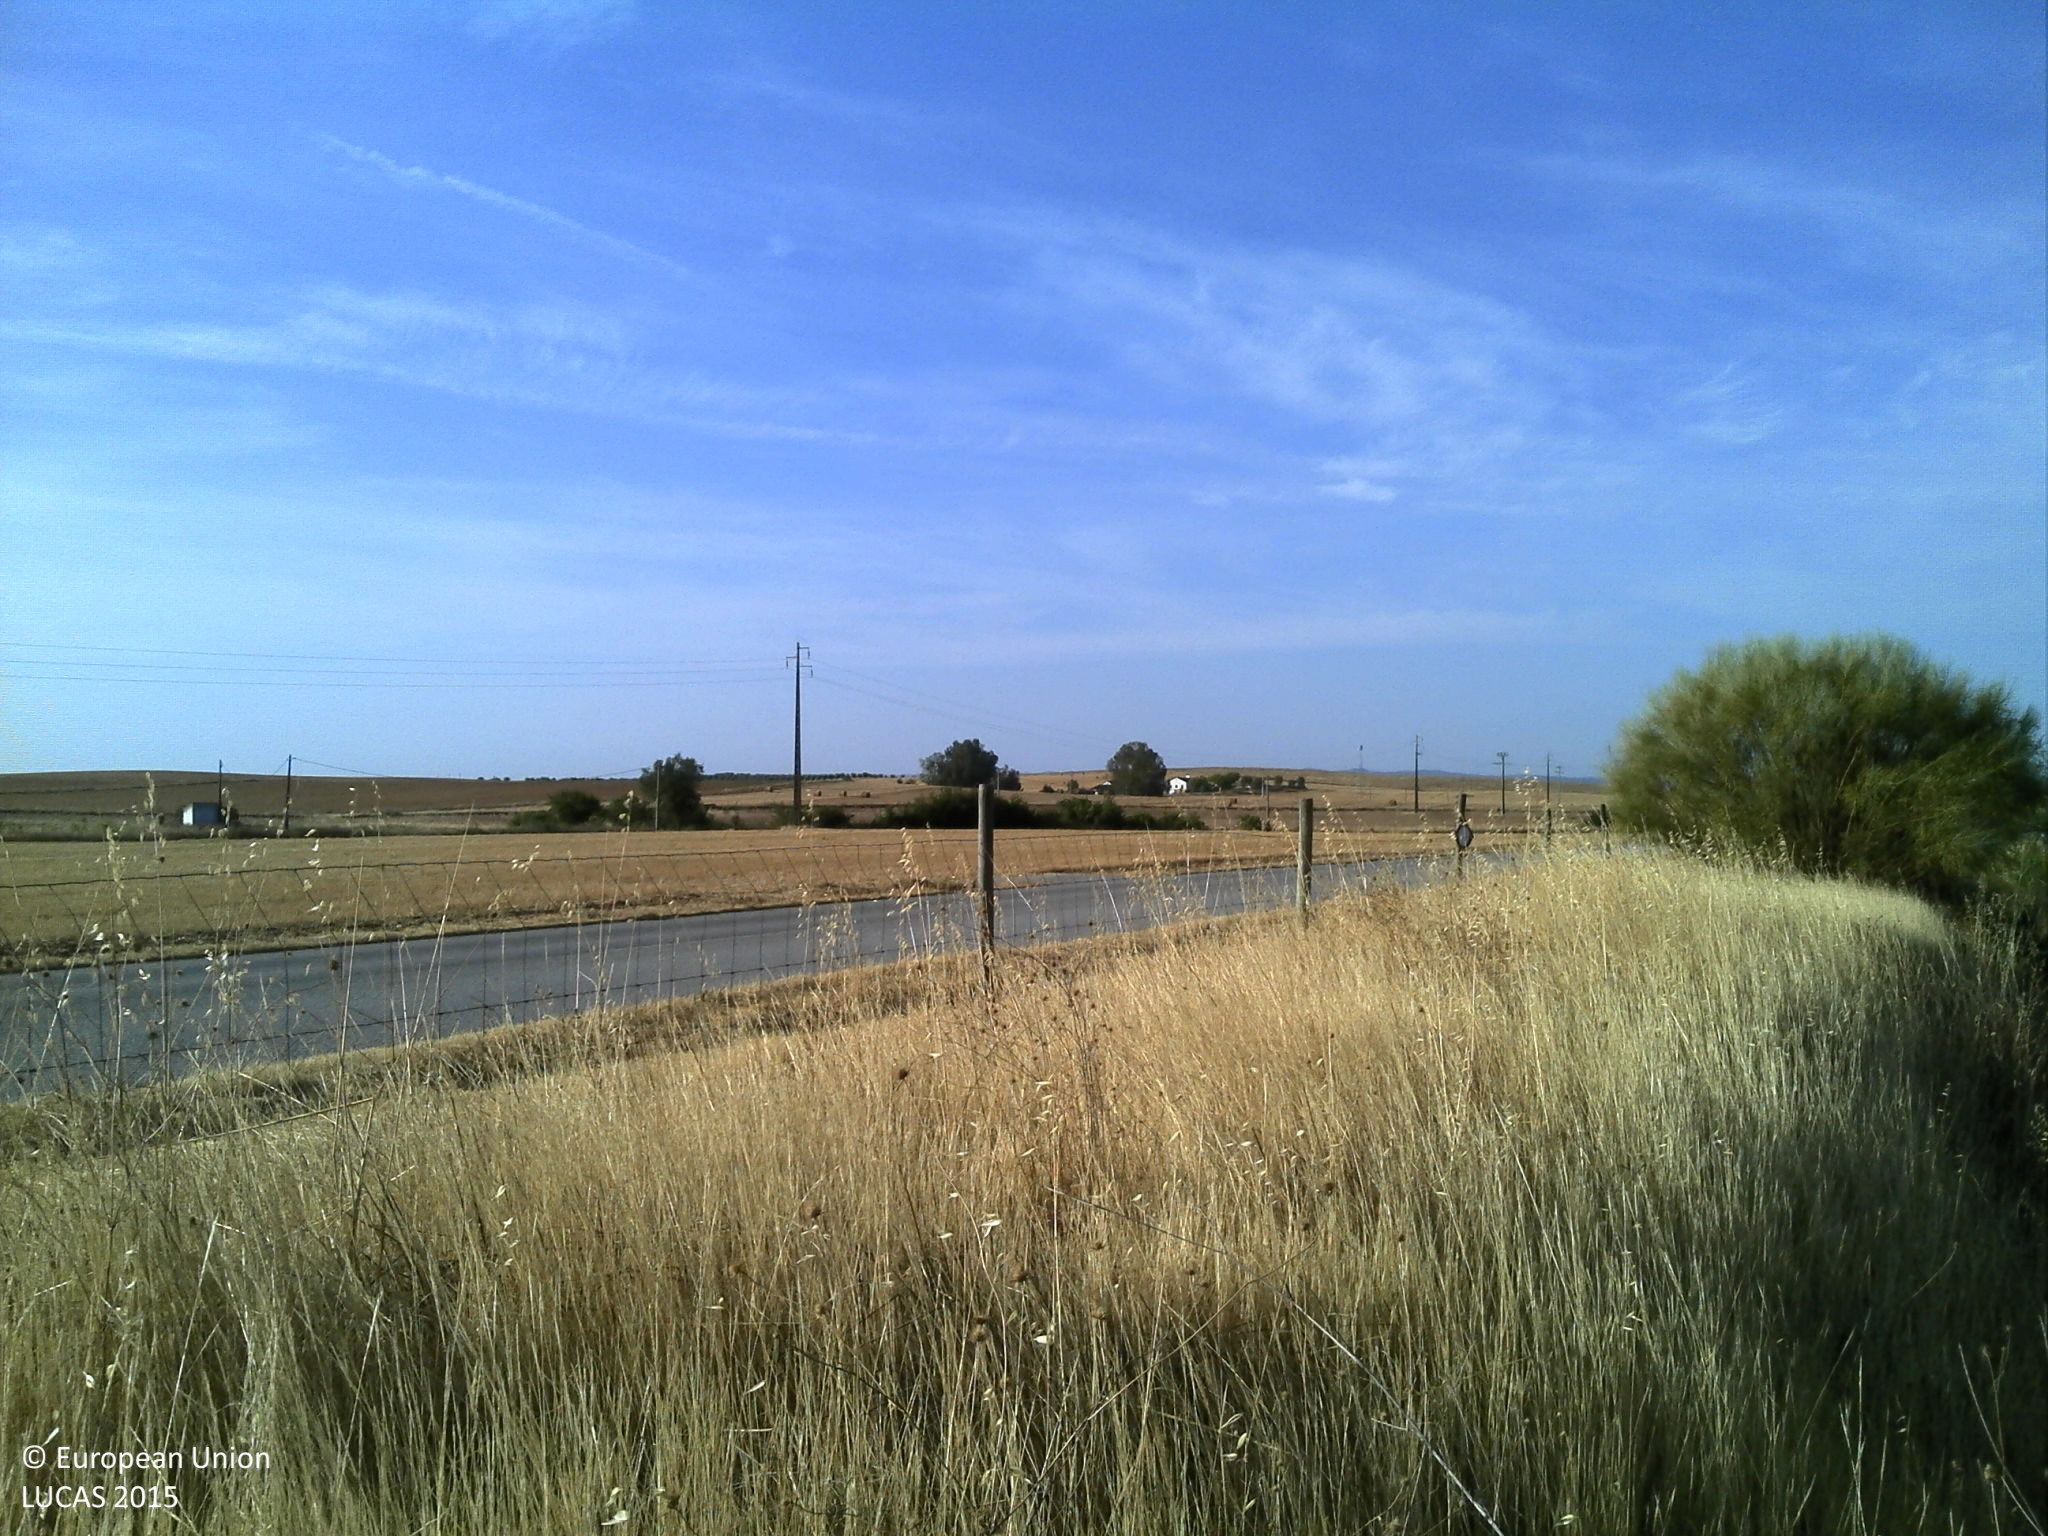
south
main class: Grassland
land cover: Grassland without tree/shrub cover
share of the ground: 50 - 75 %
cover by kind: herbaceous plants 70 %, unconsolidated bare surface 30 %
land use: Road transport
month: July
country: PT
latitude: 38.4870
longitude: -7.7464
